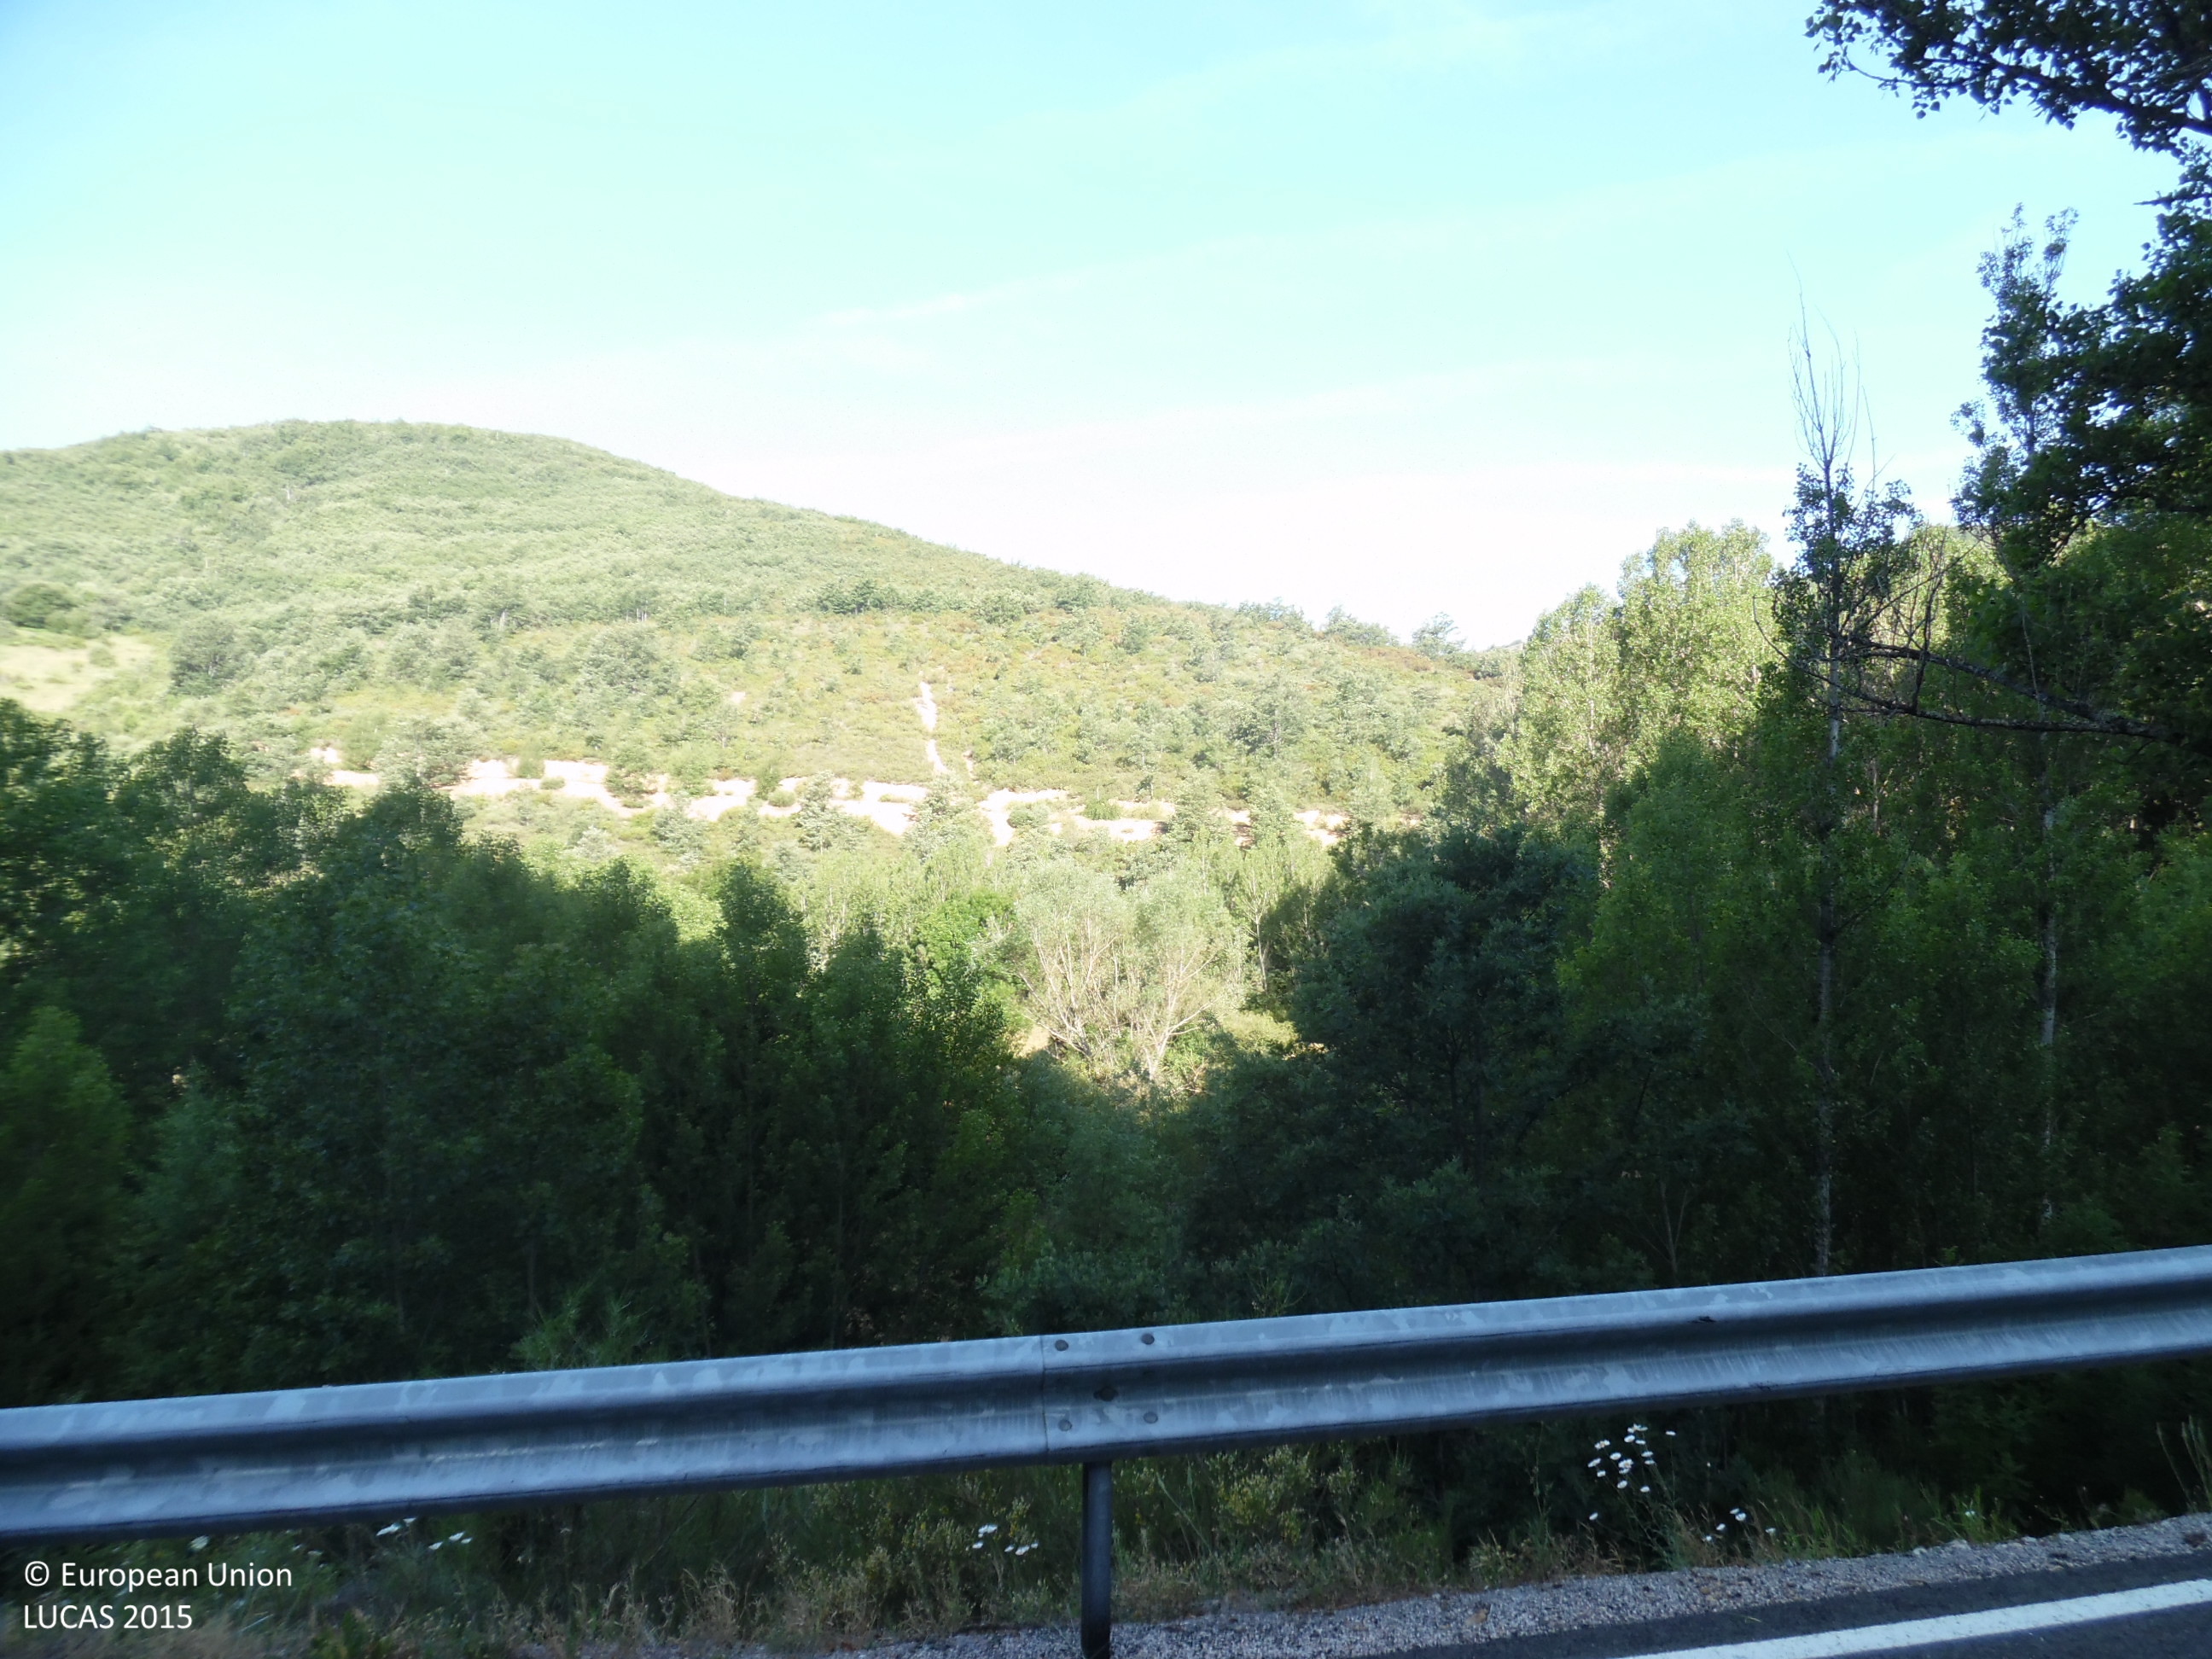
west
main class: Shrubland
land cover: Shrubland with sparse tree cover
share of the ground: > 75 %
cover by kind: shrubs 85 %, unconsolidated bare surface 10 %, broadleaved forest trees 5 %
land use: Abandoned areas
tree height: < 5 m
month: June
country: ES
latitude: 42.8054
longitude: -5.7683
